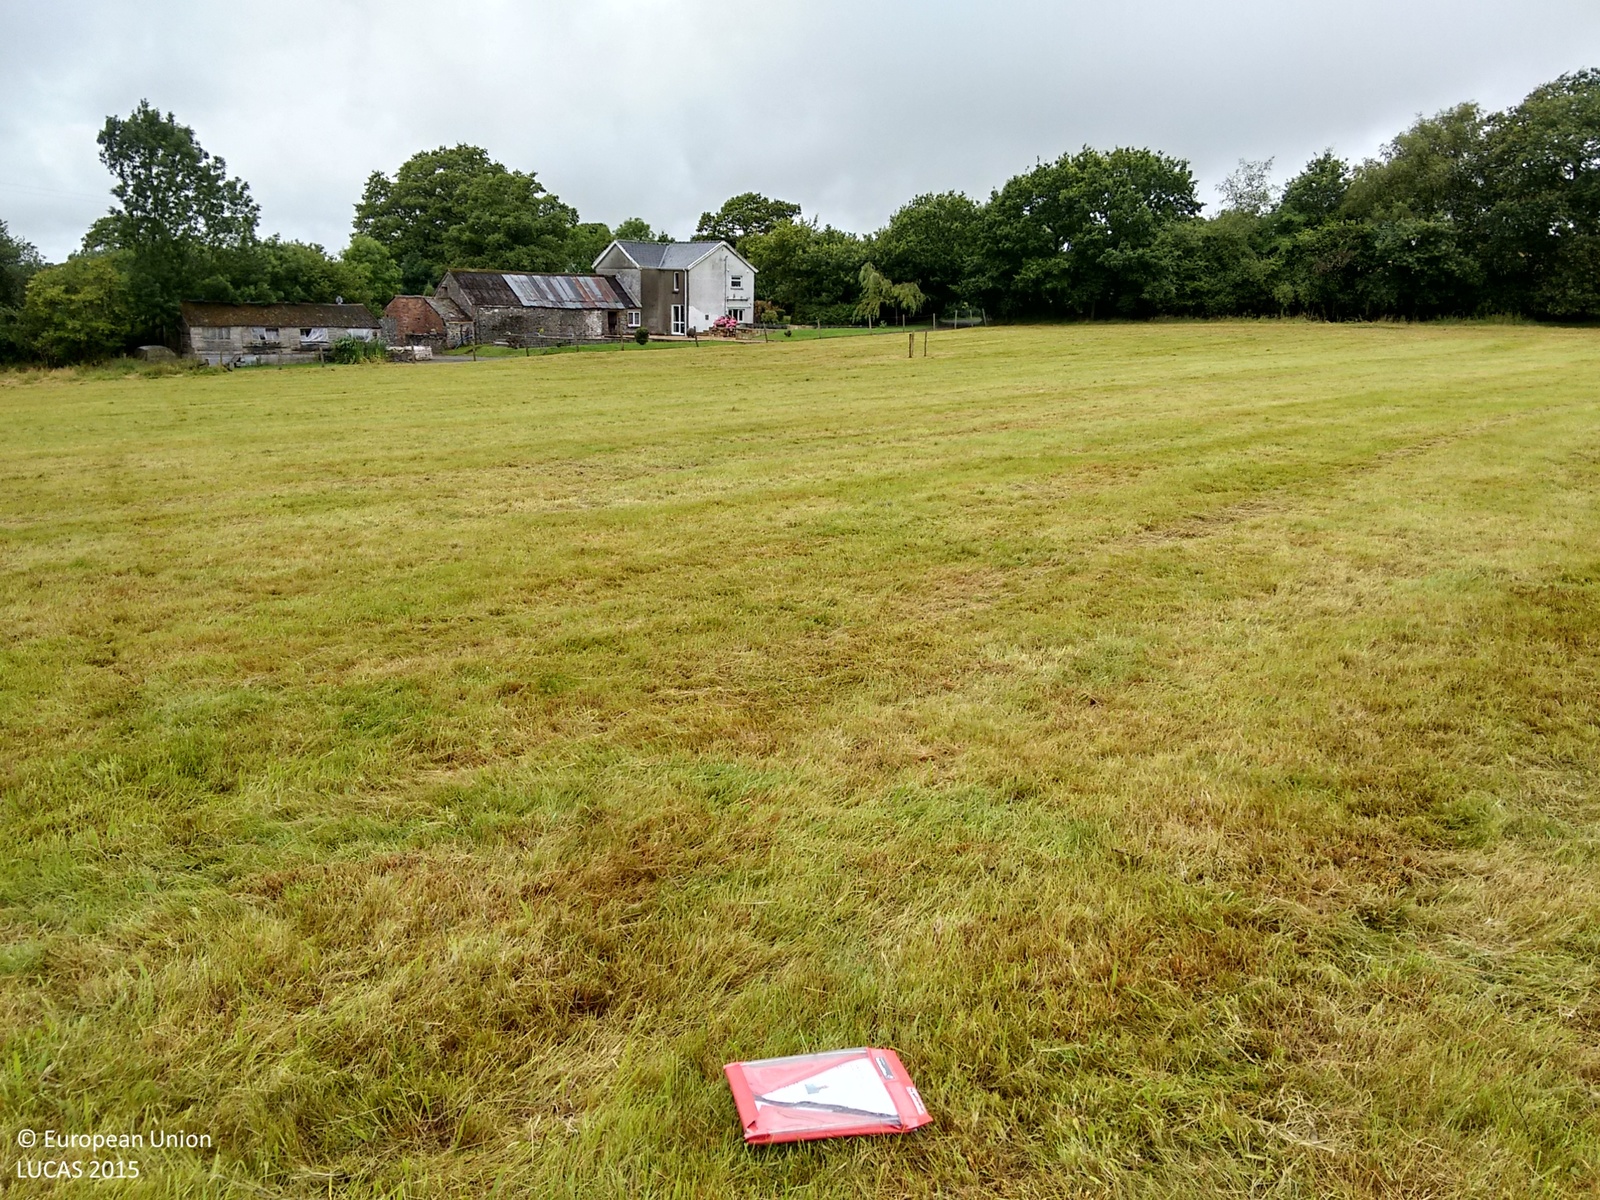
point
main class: Grassland
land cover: Grassland without tree/shrub cover
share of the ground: > 75 %
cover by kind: herbaceous plants 100 %
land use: Agriculture (excluding fallow land and kitchen gardens)
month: August
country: GB
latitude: 51.9034
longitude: -4.0339
